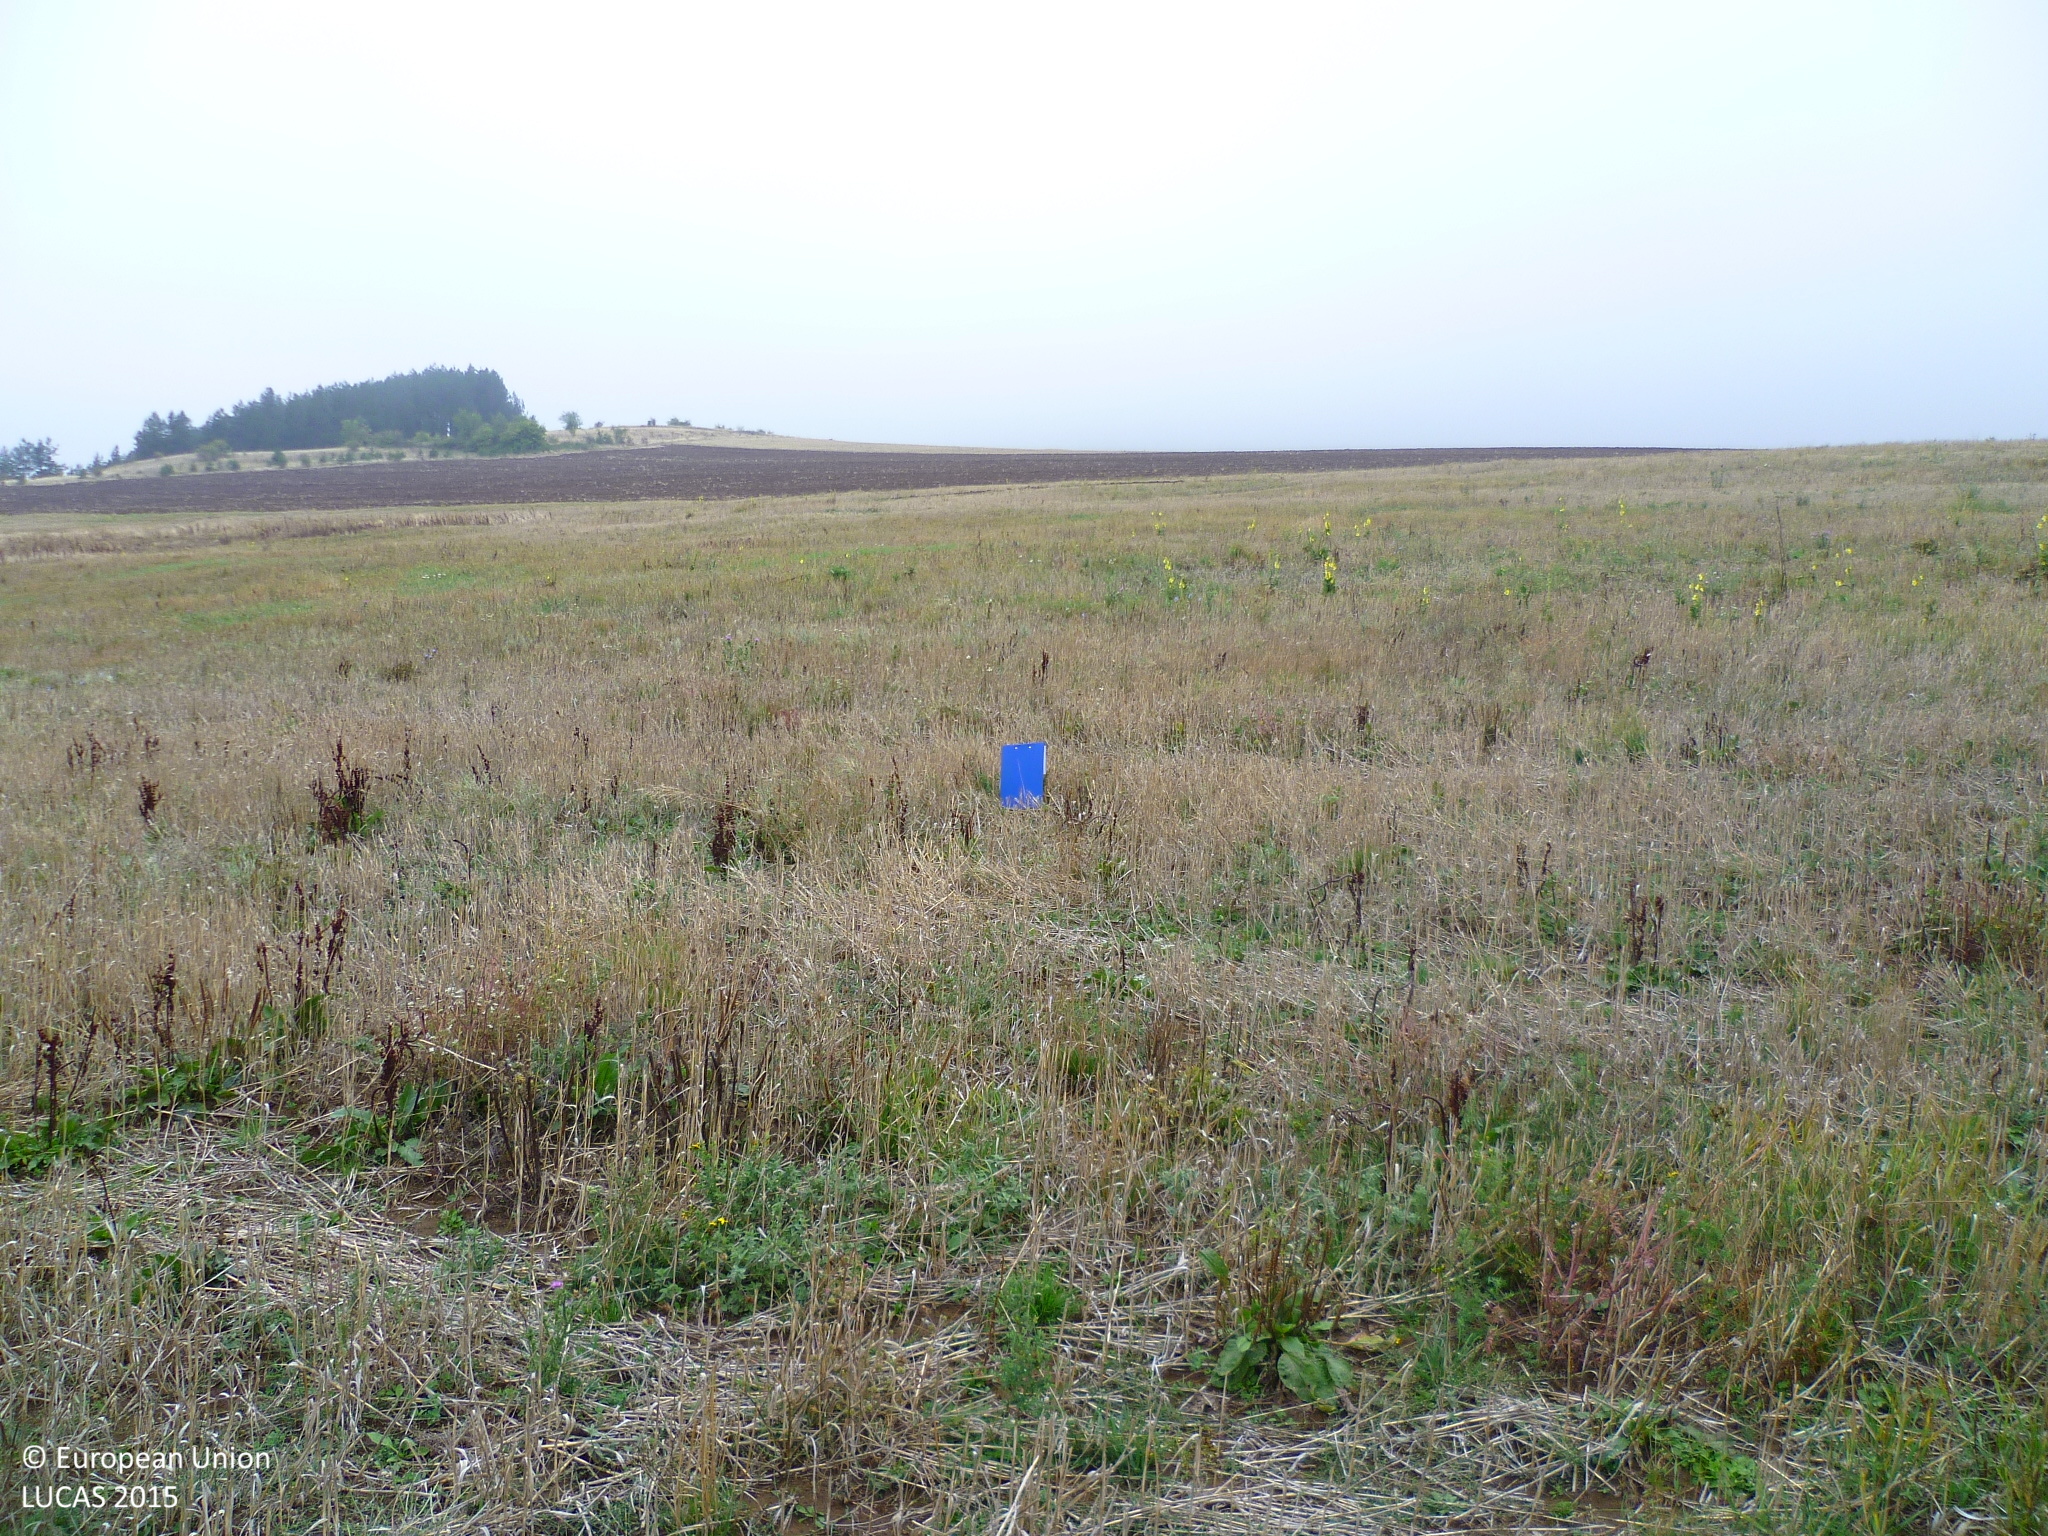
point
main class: Cropland
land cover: Barley
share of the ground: > 75 %
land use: Agriculture (excluding fallow land and kitchen gardens)
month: September
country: BG
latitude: 42.8013
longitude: 22.9793
